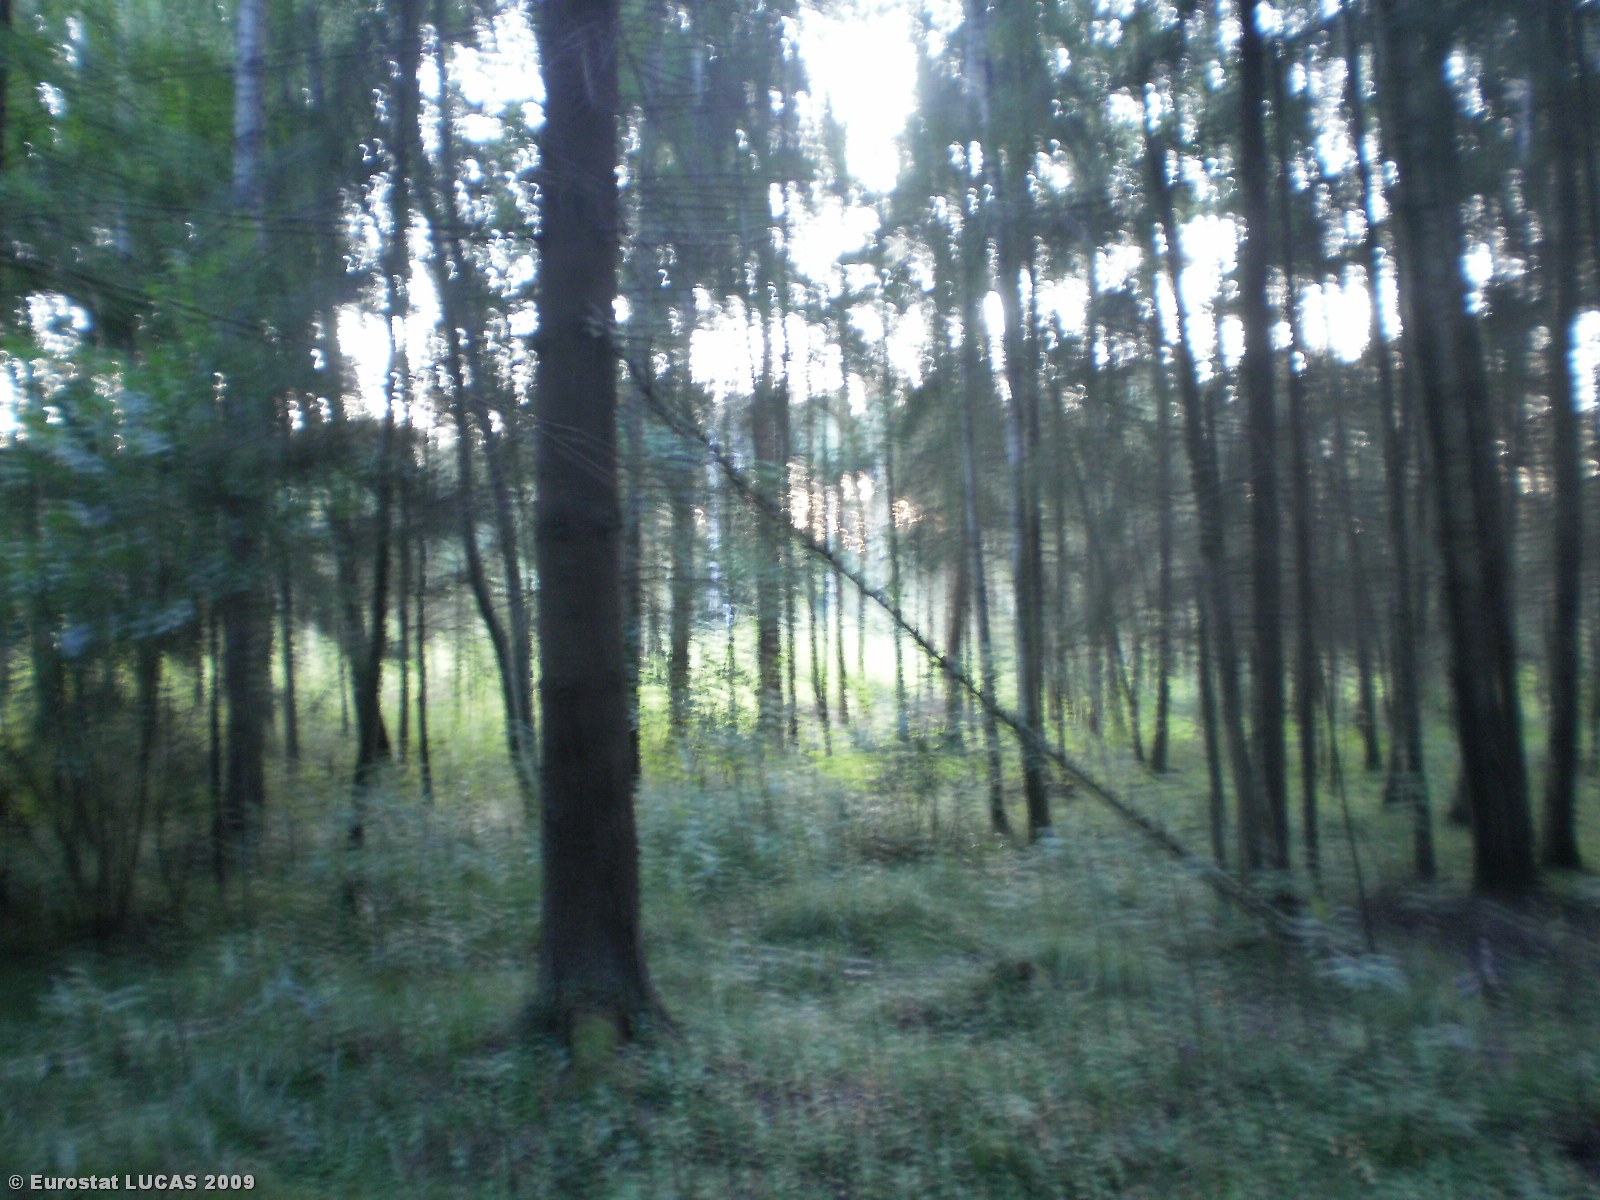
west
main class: Woodland
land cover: Coniferous woodland
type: boreal forest
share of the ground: 25 - 50 %
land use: Forestry
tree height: > 5 m
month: July
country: LT
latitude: 55.9083
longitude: 25.2658
